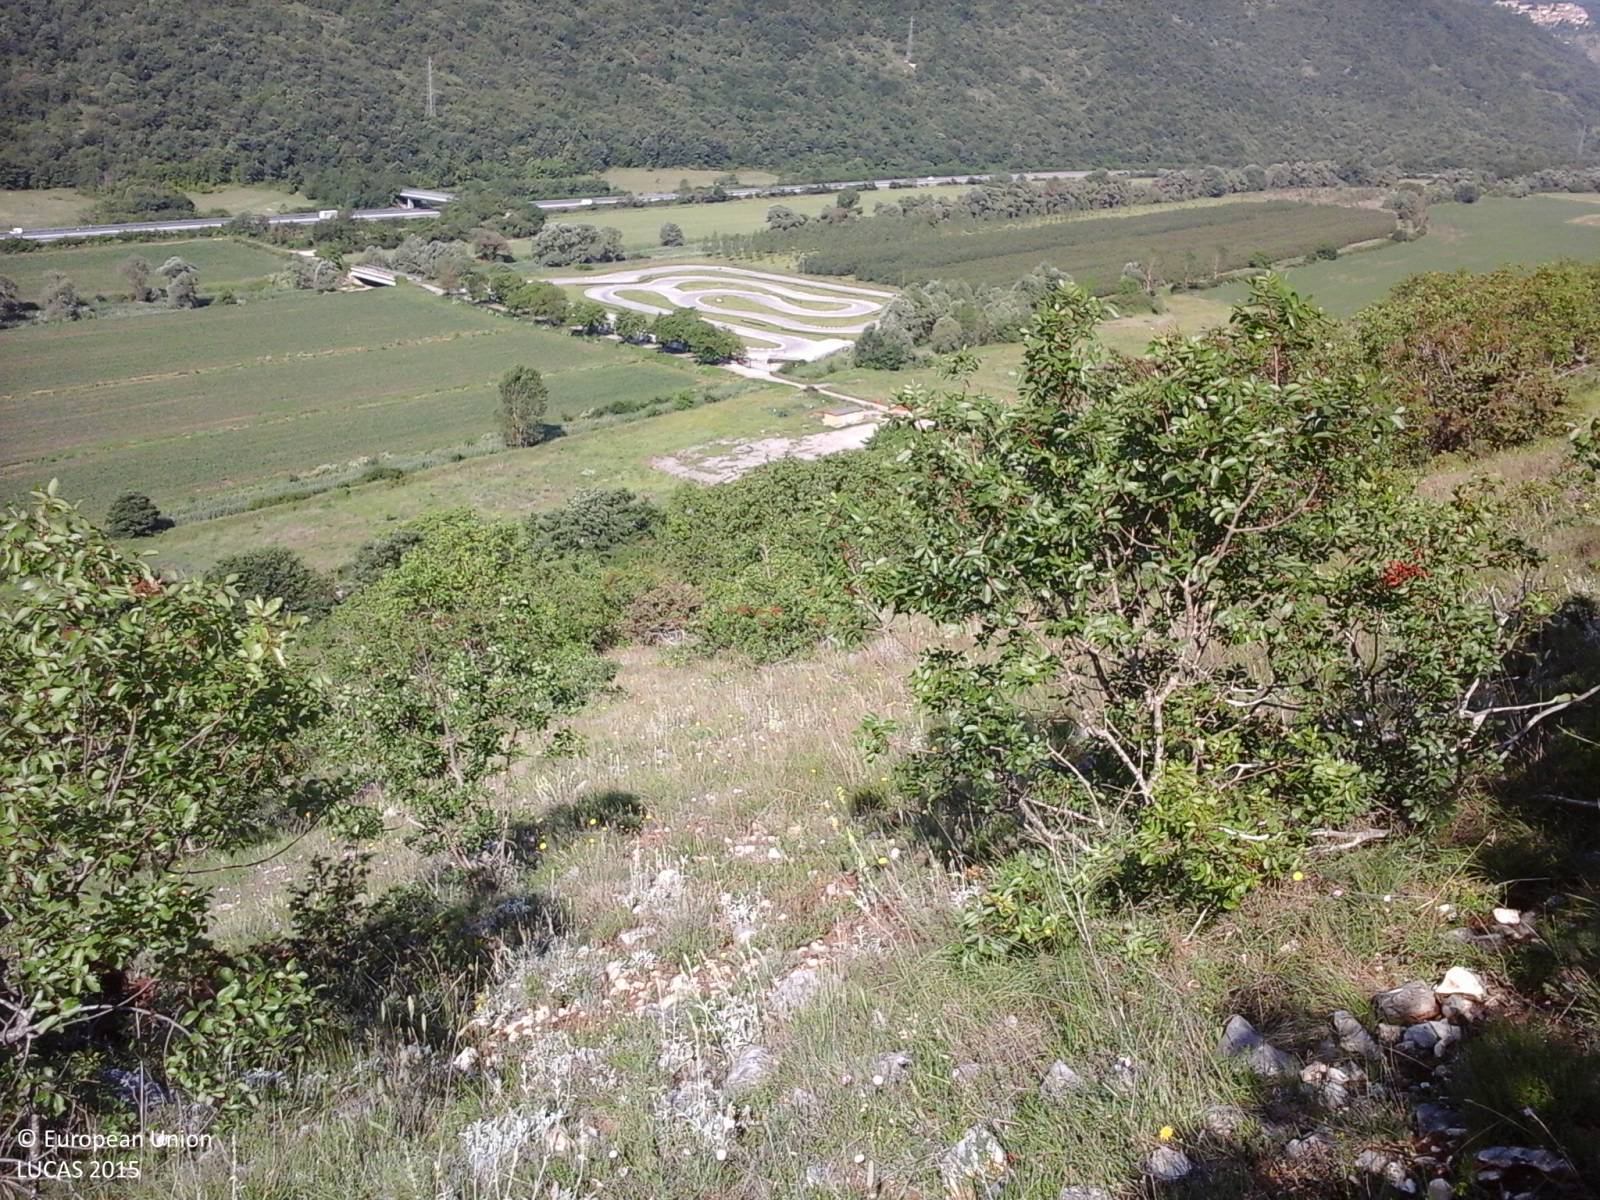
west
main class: Shrubland
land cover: Shrubland without tree cover
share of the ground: > 75 %
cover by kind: shrubs 70 %, herbaceous plants 25 %, unconsolidated bare surface 5 %
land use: Semi-natural and natural areas not in use
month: June
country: IT
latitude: 42.1117
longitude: 13.3145
